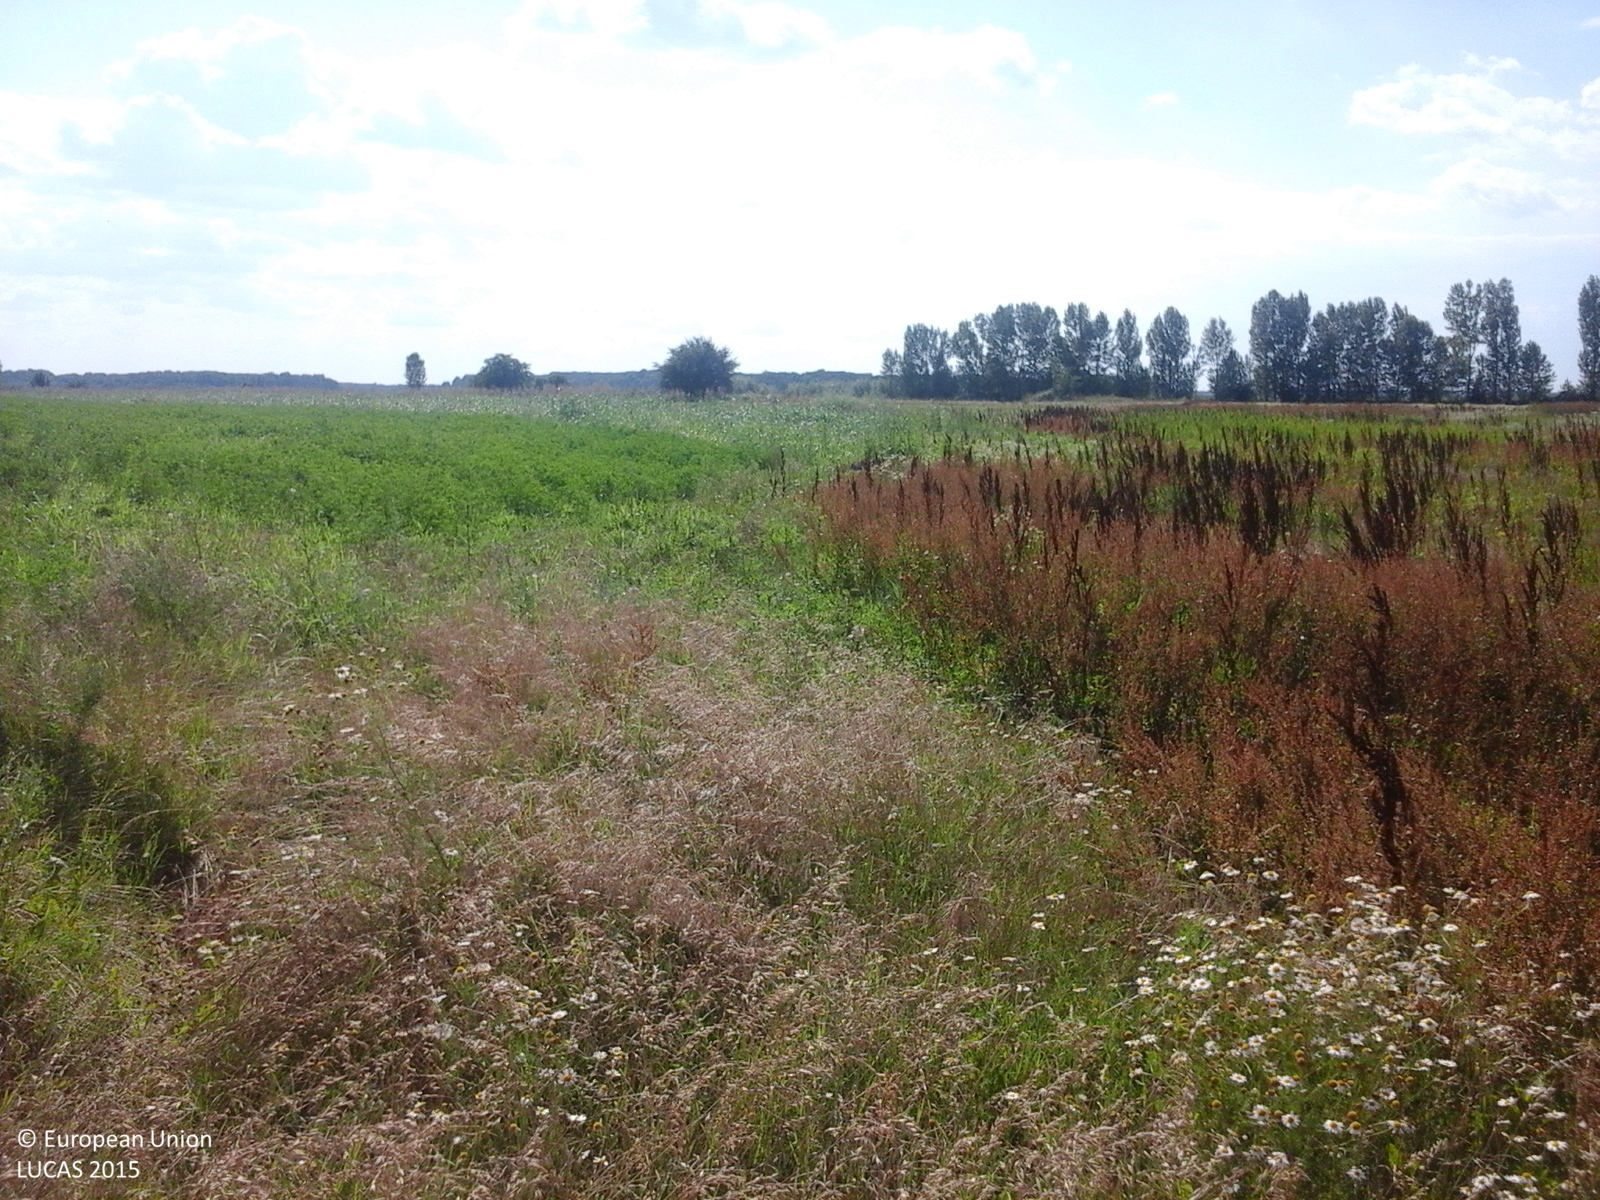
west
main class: Grassland
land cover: Grassland without tree/shrub cover
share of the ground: > 75 %
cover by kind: herbaceous plants 100 %
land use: Agriculture (excluding fallow land and kitchen gardens)
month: July
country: RO
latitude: 44.0566
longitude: 24.6370
